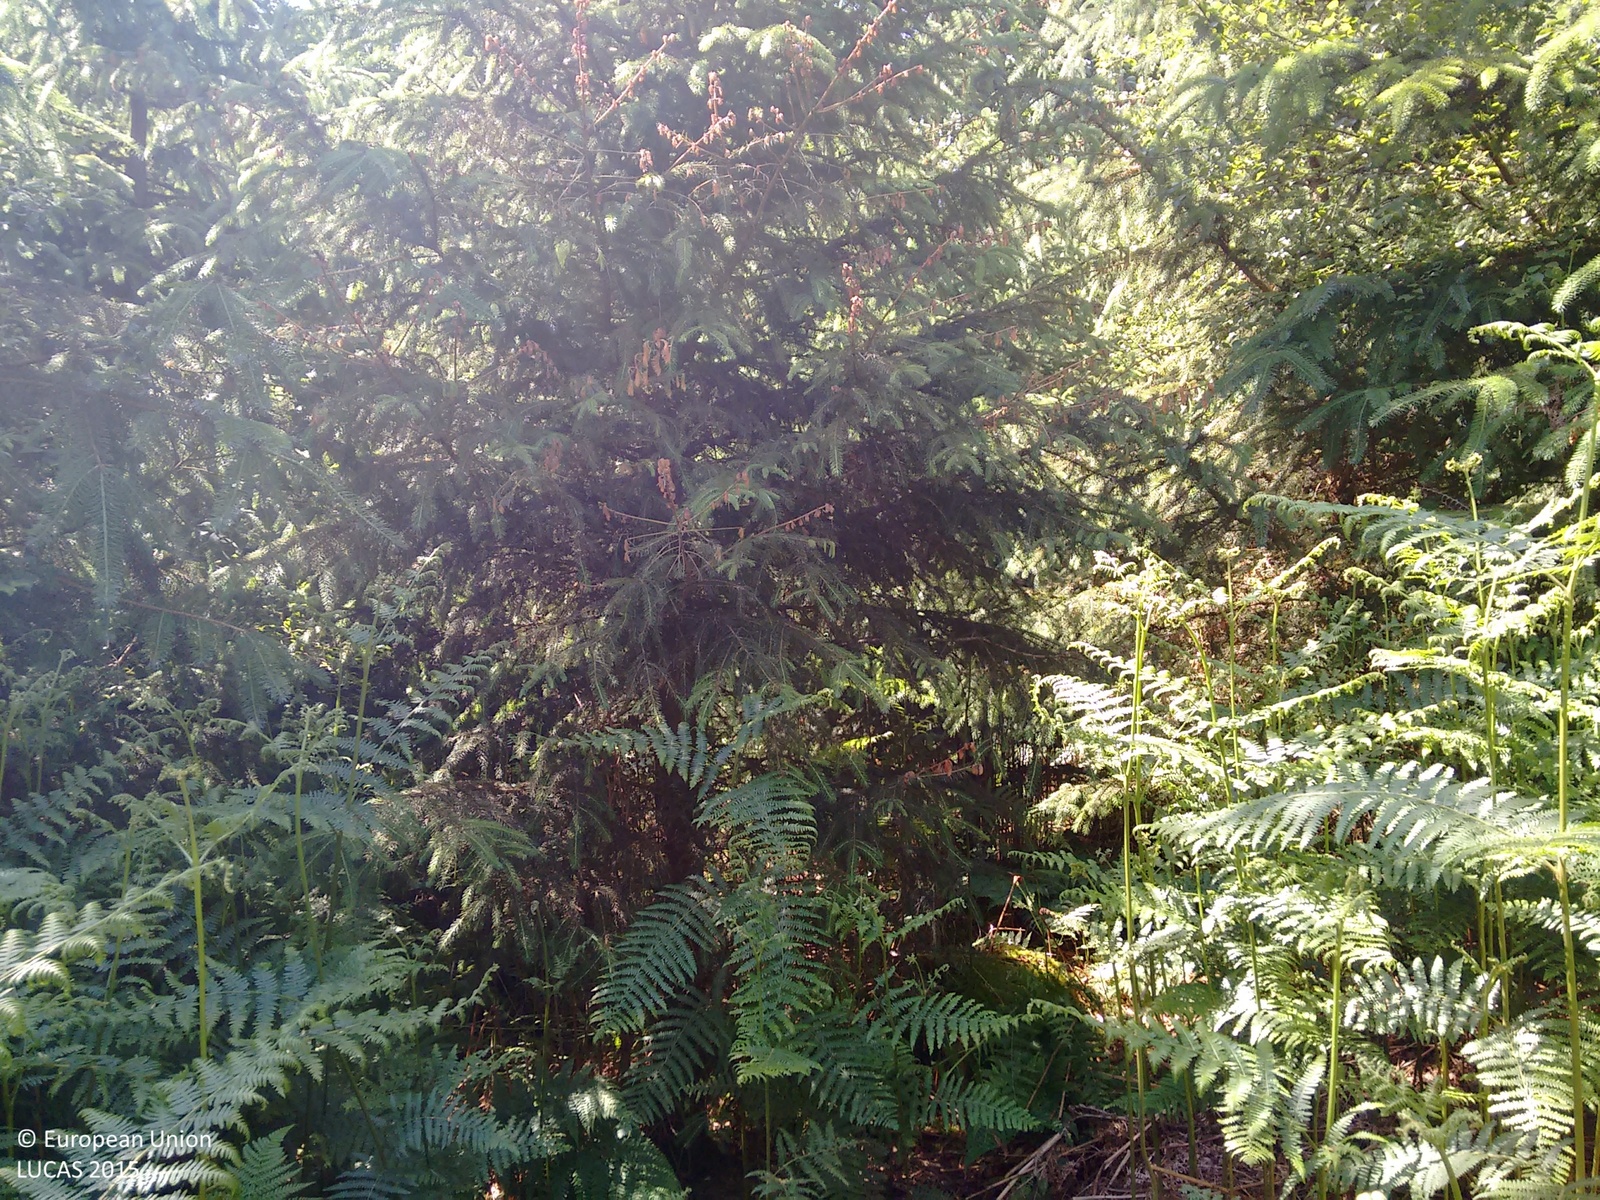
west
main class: Woodland
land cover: Spruce dominated mixed woodland
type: exotic forest
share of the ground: > 75 %
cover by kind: coniferous forest trees 75 %, broadleaved forest trees 25 %
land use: Forestry
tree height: > 5 m
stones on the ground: < 10 %
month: July
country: GB
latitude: 55.0011
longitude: -3.4461
